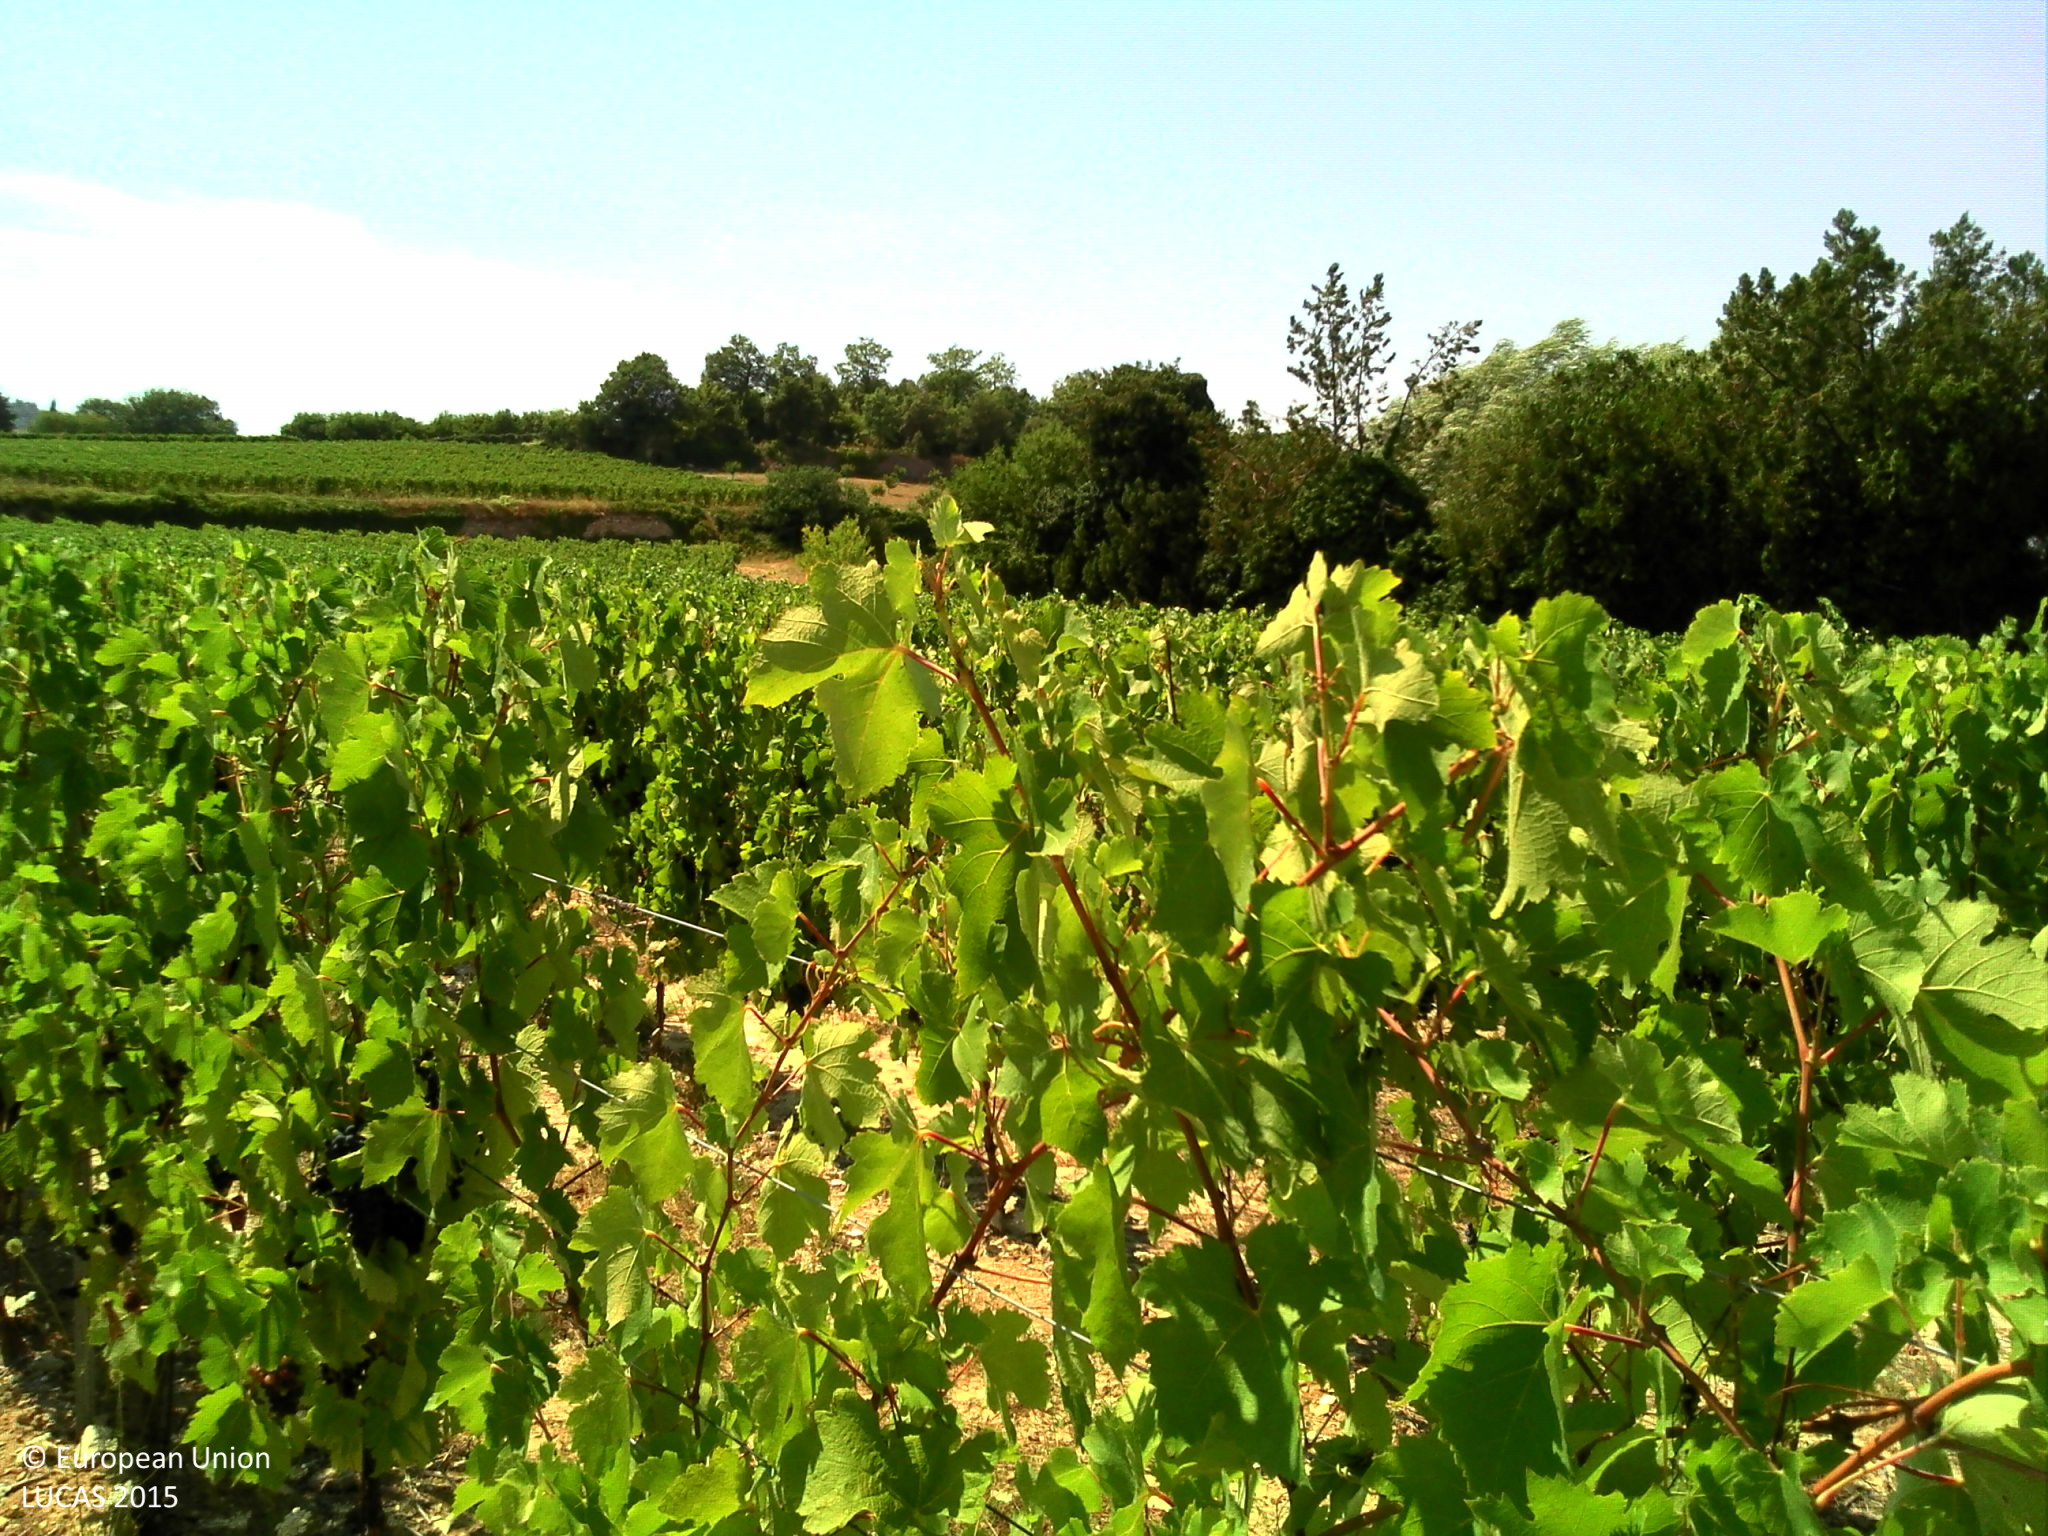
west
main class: Cropland
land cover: Vineyards
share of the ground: 25 - 50 %
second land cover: Other bare soil
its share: > 75 %
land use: Agriculture (excluding fallow land and kitchen gardens)
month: August
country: FR
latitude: 43.8284
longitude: 5.2960
